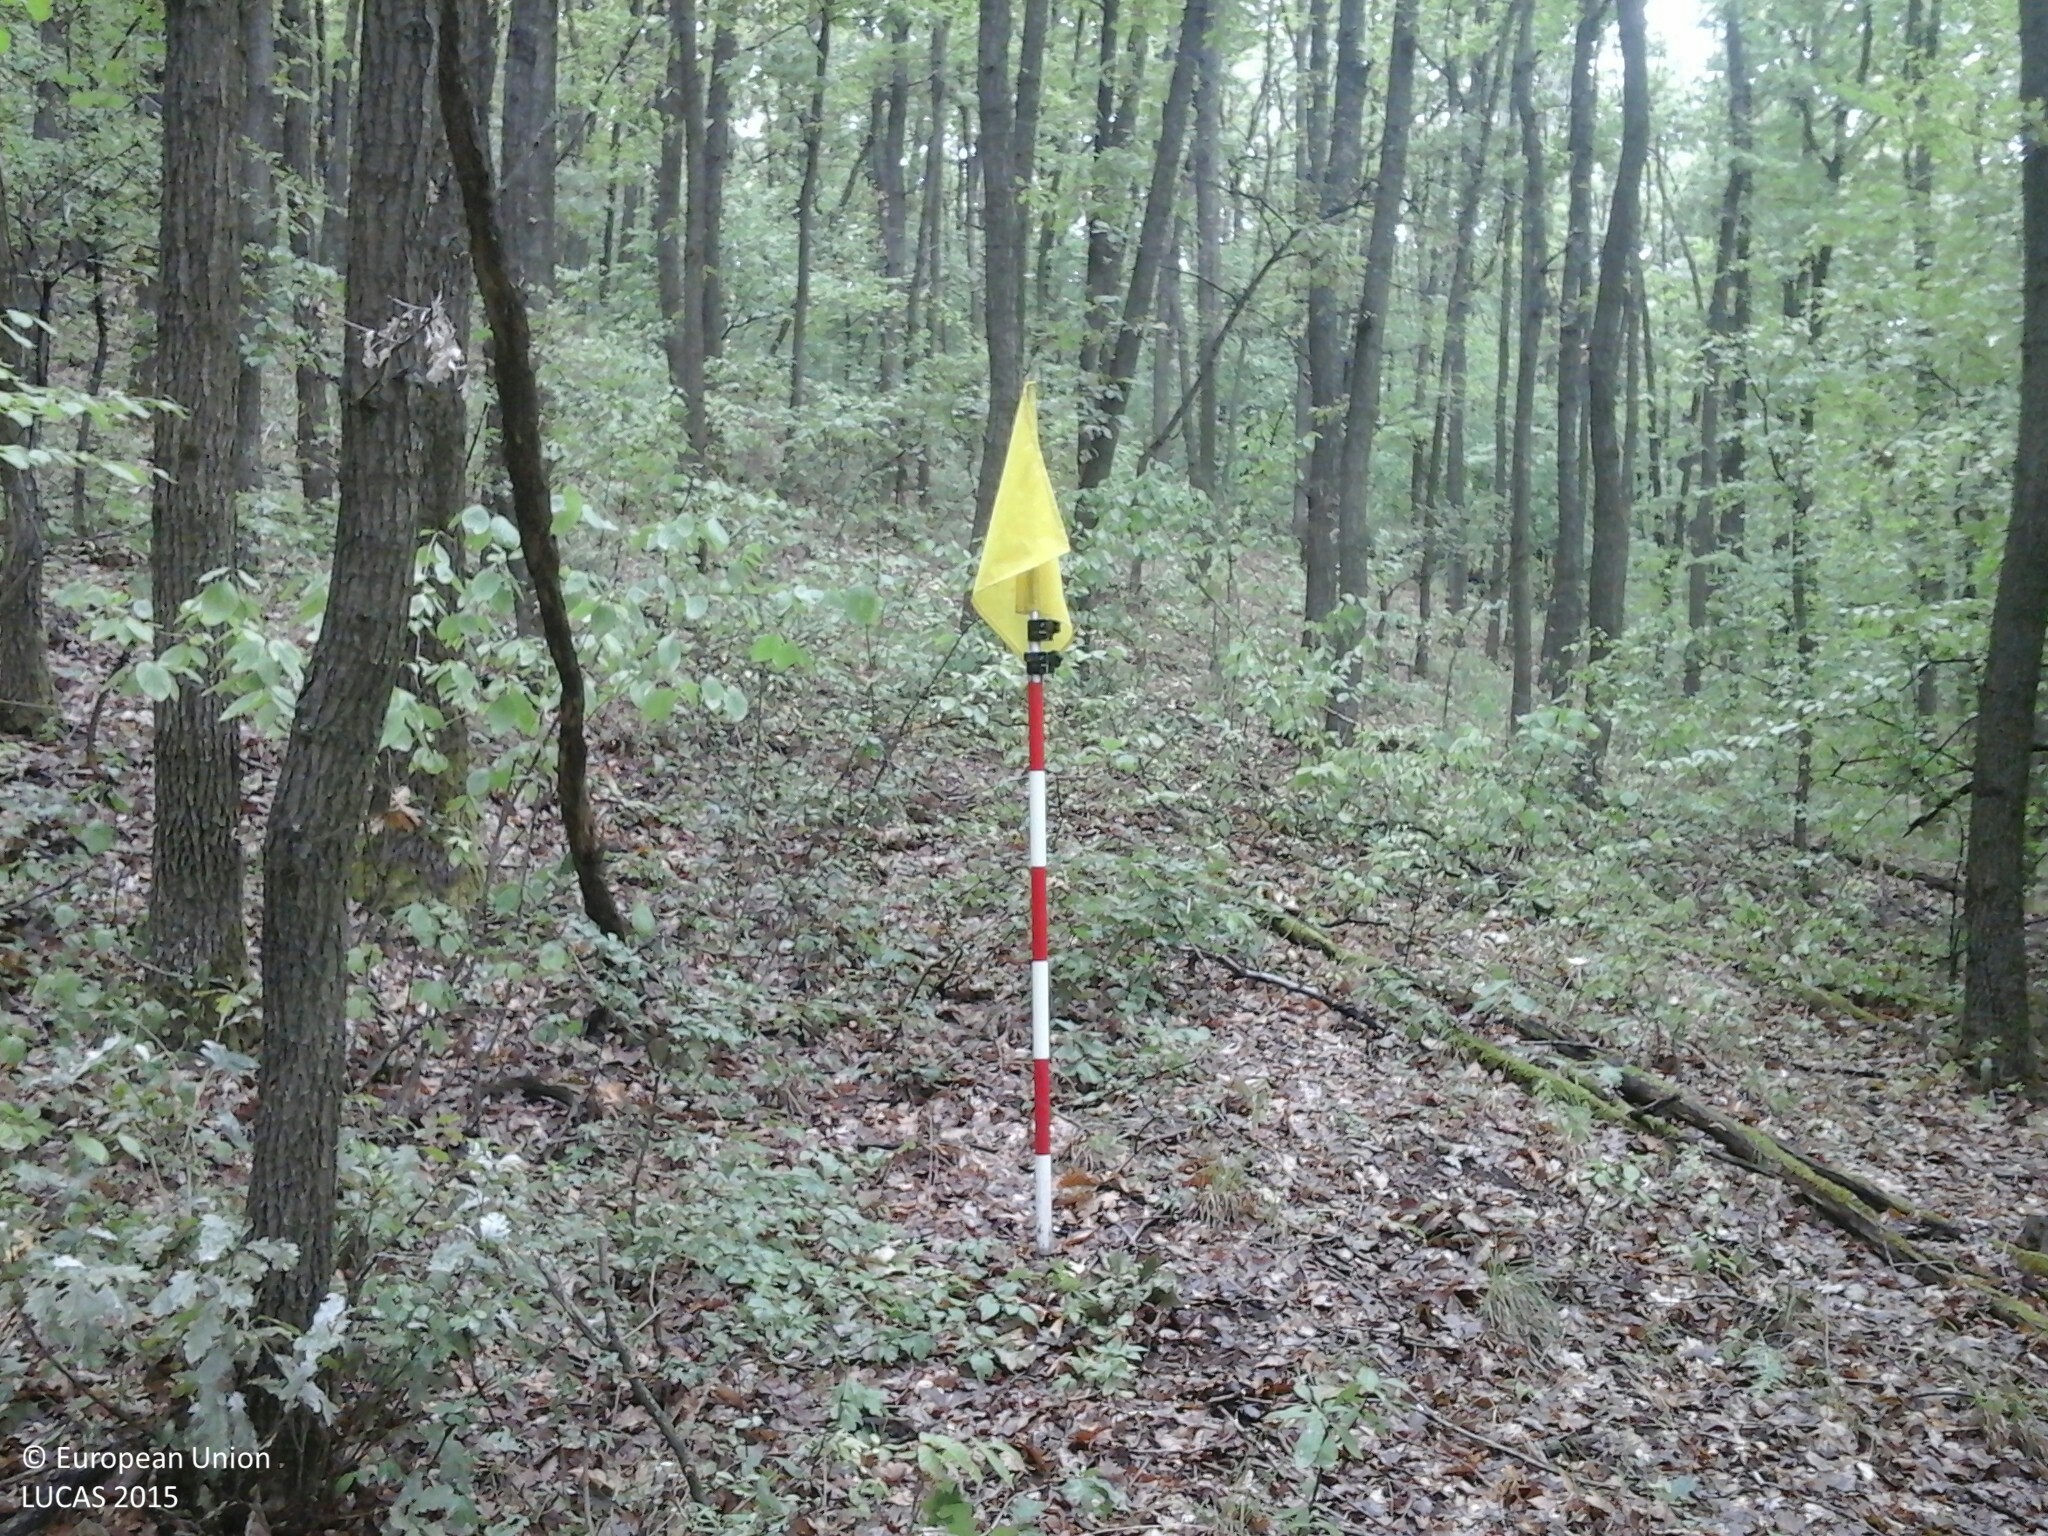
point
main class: Woodland
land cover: Broadleaved woodland
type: acidophilous oak and oak-birch forest
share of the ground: > 75 %
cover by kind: broadleaved forest trees 85 %, shrubs 15 %
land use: Forestry
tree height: > 5 m
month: July
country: HU
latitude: 47.9700
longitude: 20.3589
